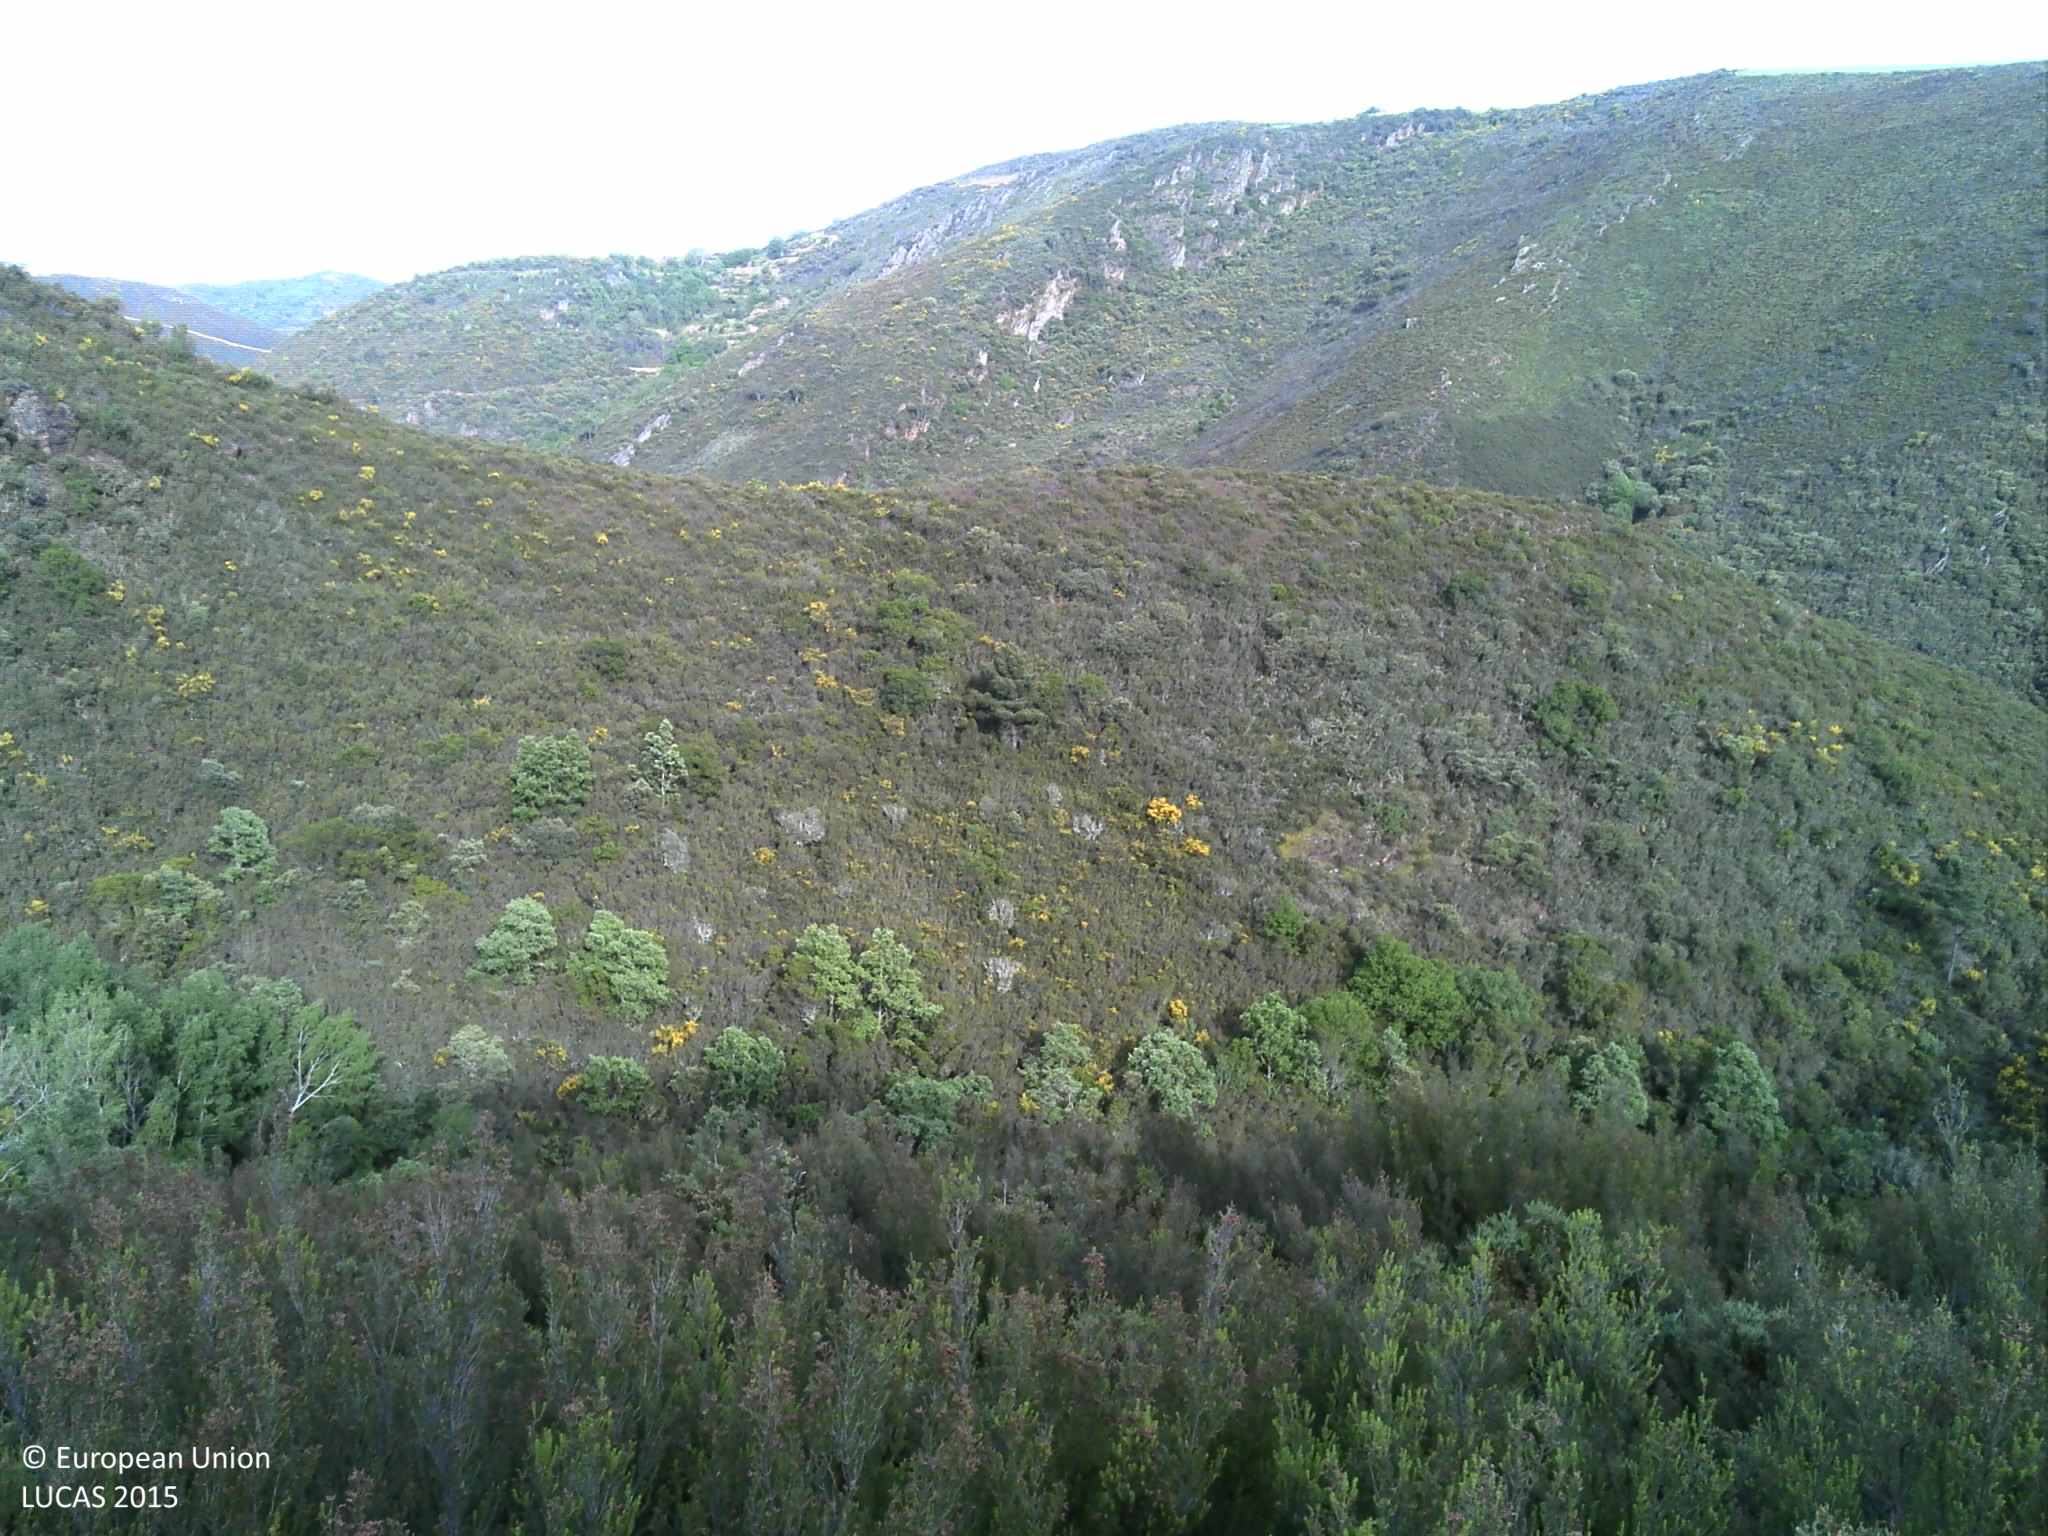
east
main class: Shrubland
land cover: Shrubland with sparse tree cover
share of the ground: > 75 %
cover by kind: shrubs 85 %, unconsolidated bare surface 10 %, broadleaved forest trees 5 %
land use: Forestry
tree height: > 5 m
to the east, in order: Shrubland with sparse tree cover; Broadleaved woodland; Rivers and streams; Broadleaved woodland; Shrubland with sparse tree cover; Shrubland without tree cover
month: May
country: PT
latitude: 41.7231
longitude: -6.9827
